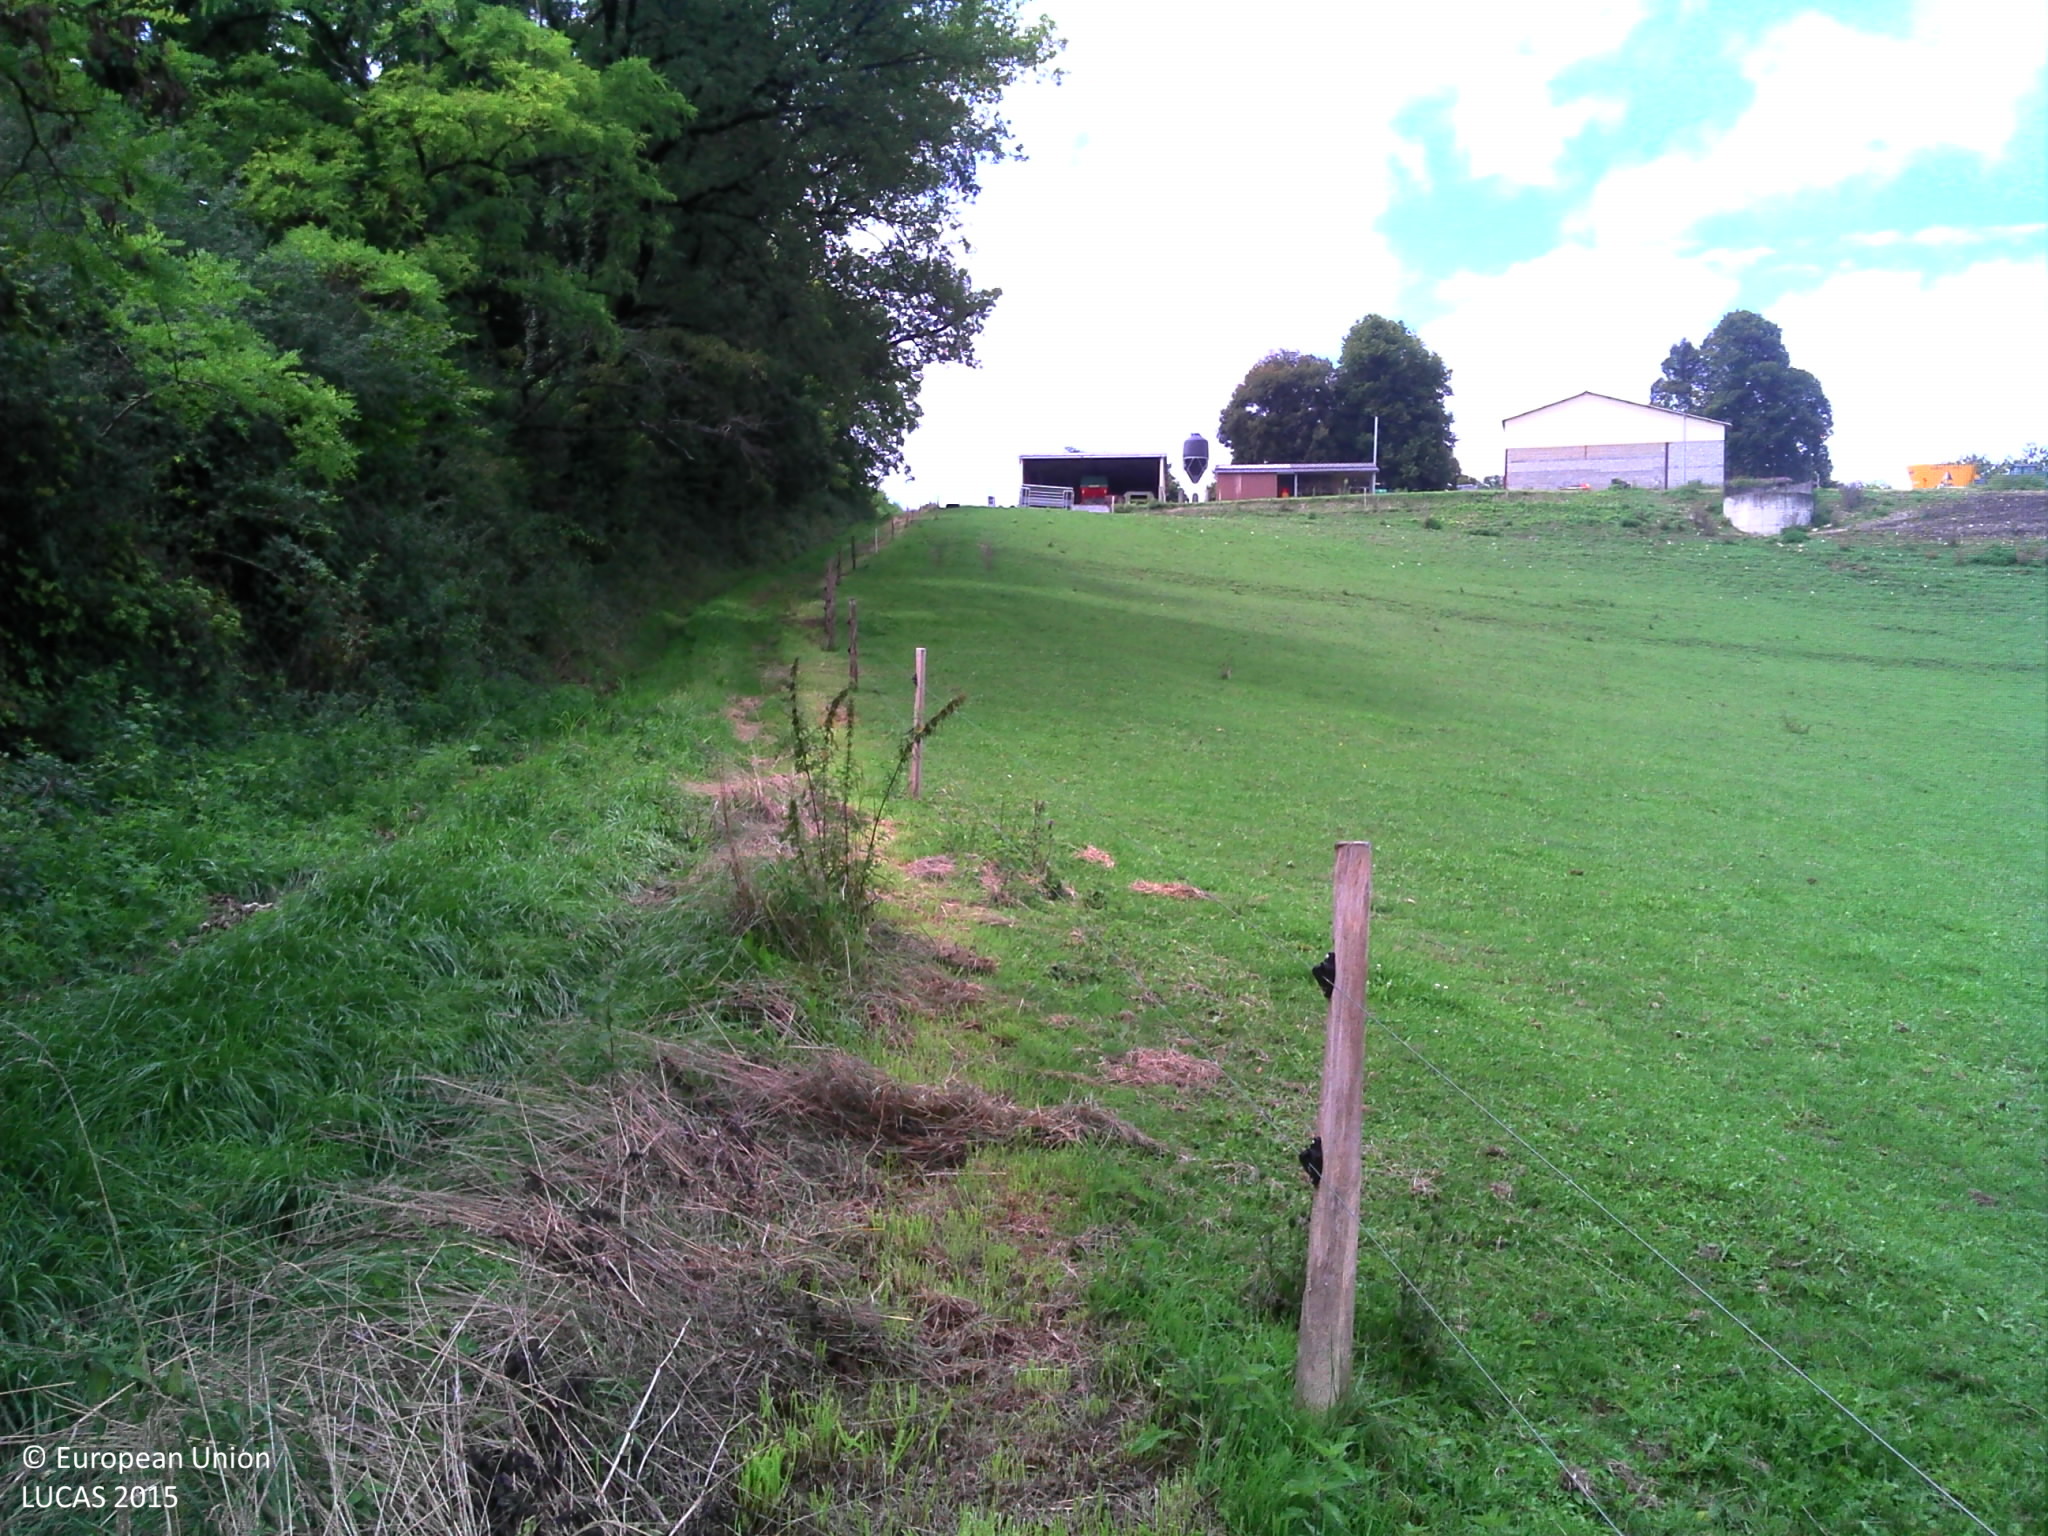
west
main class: Grassland
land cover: Grassland without tree/shrub cover
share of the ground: > 75 %
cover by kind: herbaceous plants 80 %, lichens and mosses 20 %
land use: Agriculture (excluding fallow land and kitchen gardens)
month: August
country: FR
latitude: 45.2918
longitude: 0.4887
